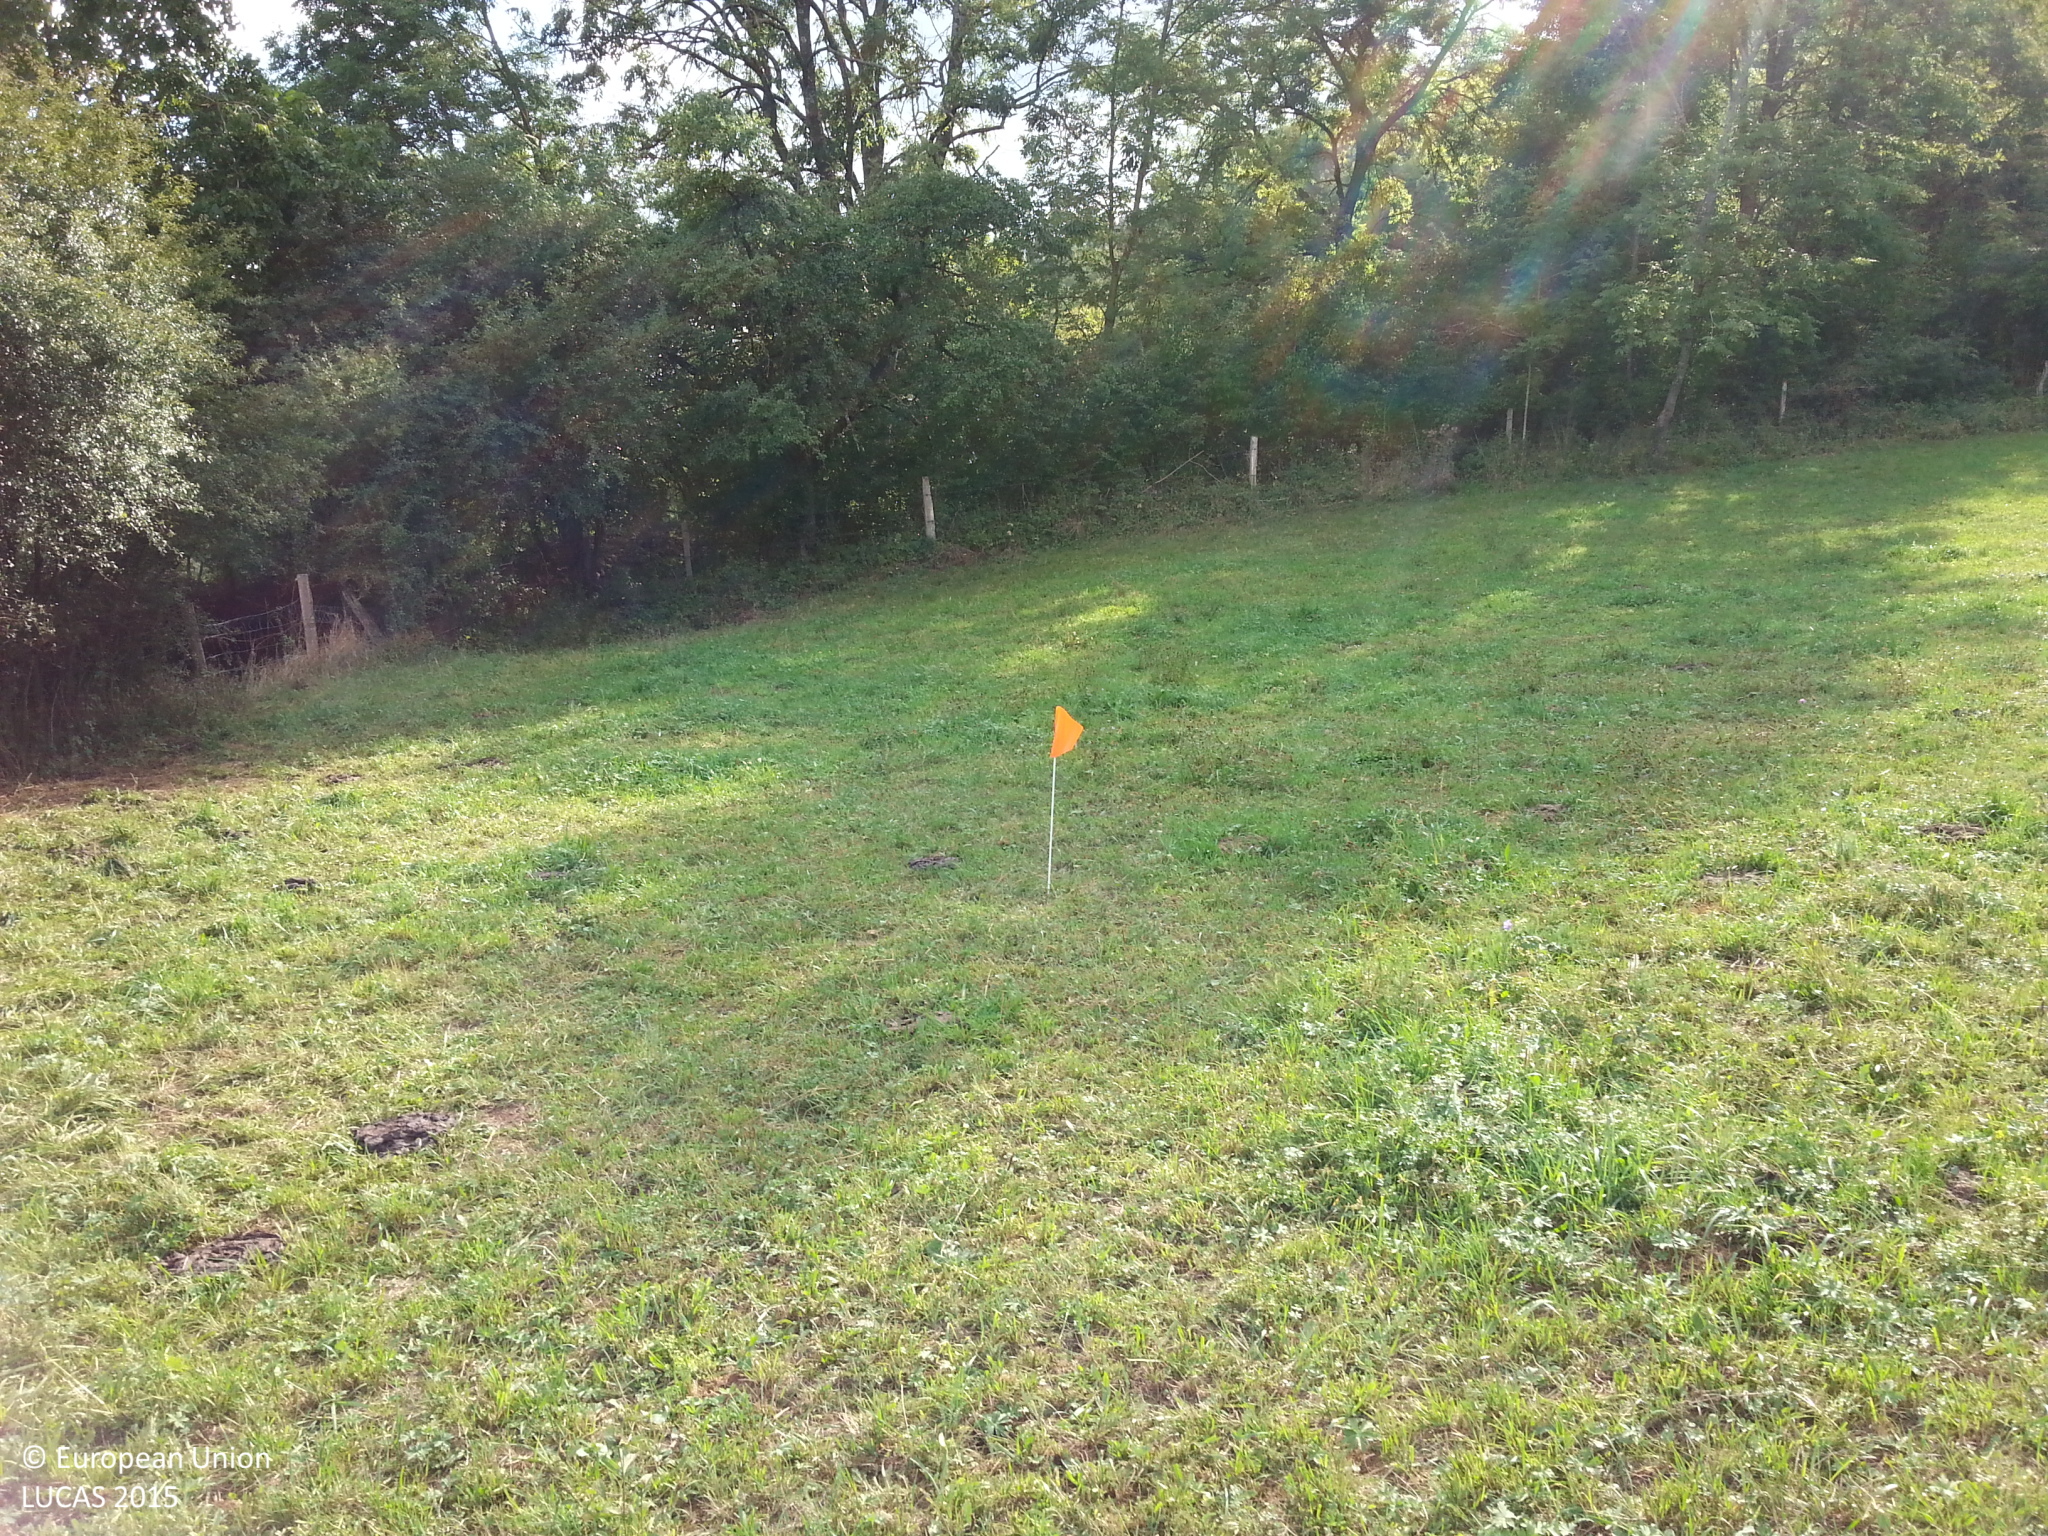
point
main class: Grassland
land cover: Grassland without tree/shrub cover
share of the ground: > 75 %
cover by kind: herbaceous plants 100 %
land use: Agriculture (excluding fallow land and kitchen gardens)
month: September
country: DE
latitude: 49.3929
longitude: 9.9036
